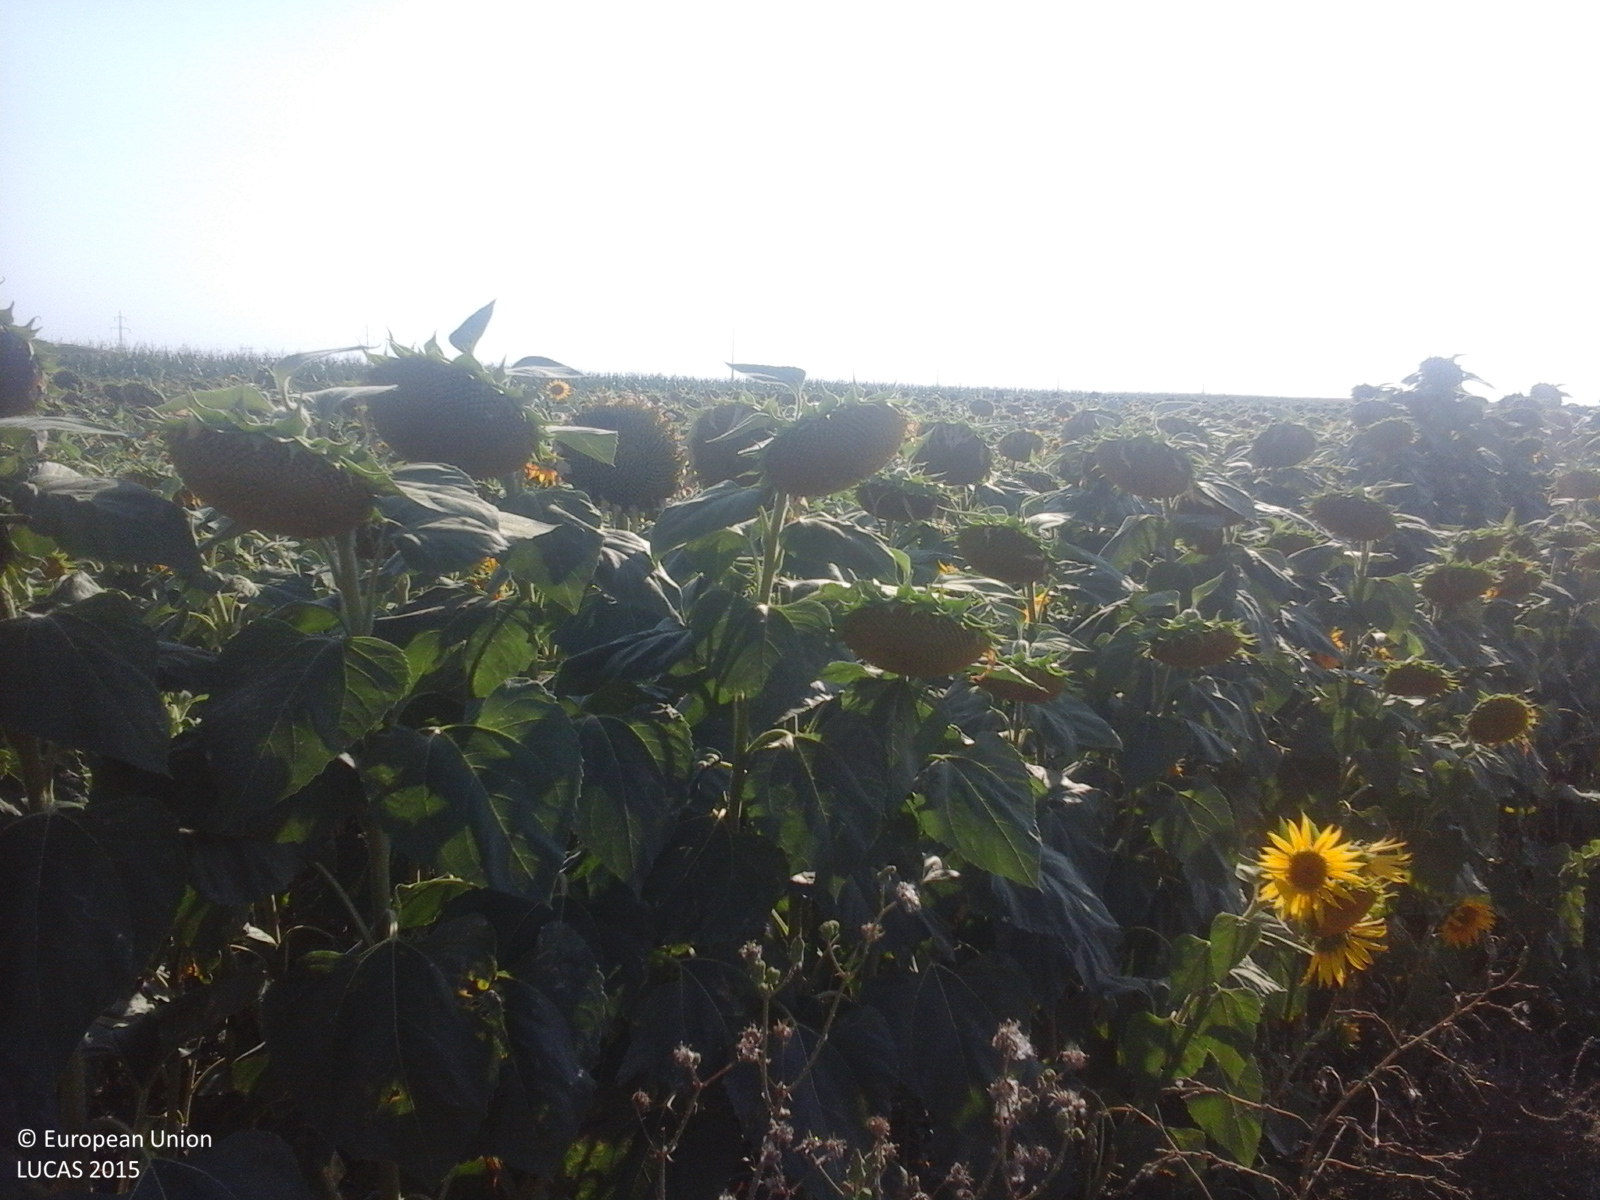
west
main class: Cropland
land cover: Sunflower
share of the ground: > 75 %
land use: Agriculture (excluding fallow land and kitchen gardens)
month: July
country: RO
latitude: 44.9461
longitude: 27.7336
